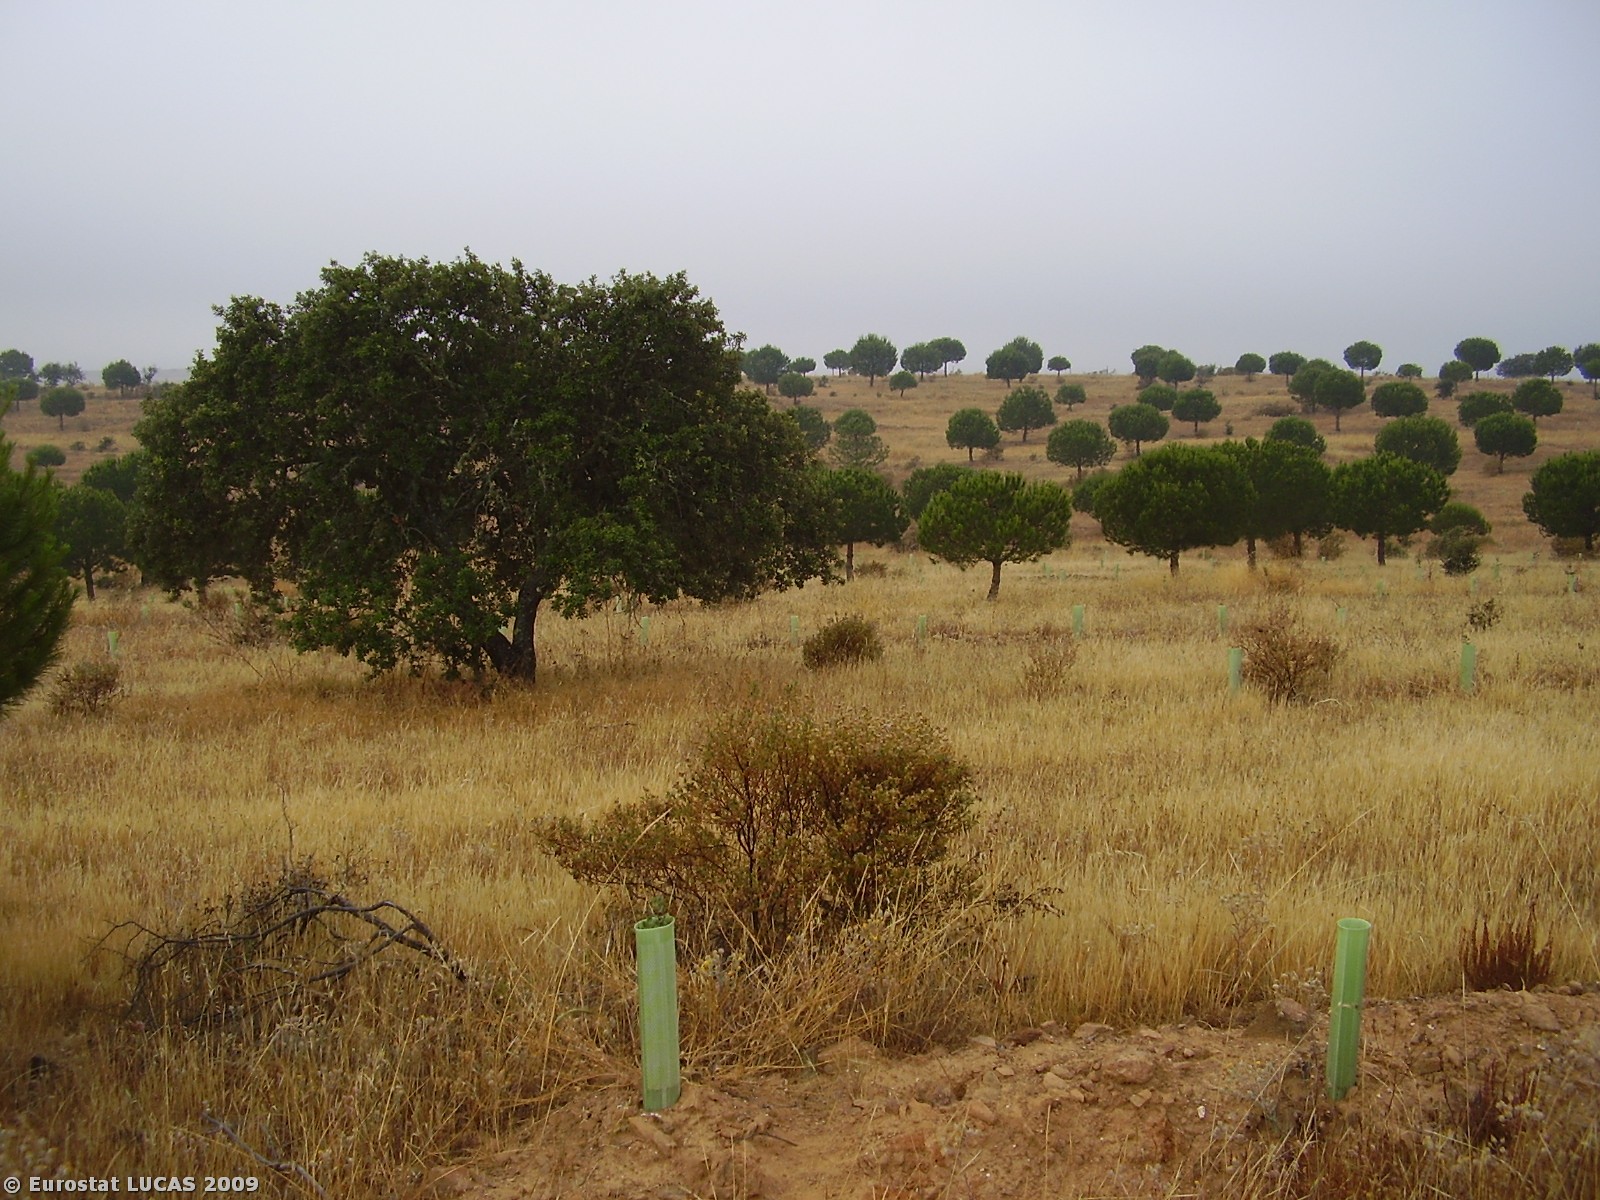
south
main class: Woodland
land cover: Mixed woodland
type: coniferous forest of the mediterranean region
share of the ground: 25 - 50 %
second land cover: Spontaneously vegetated surfaces
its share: 50 - 75 %
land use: Forestry
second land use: Fallow land
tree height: > 5 m
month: May
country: PT
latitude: 37.6160
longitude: -7.5617
